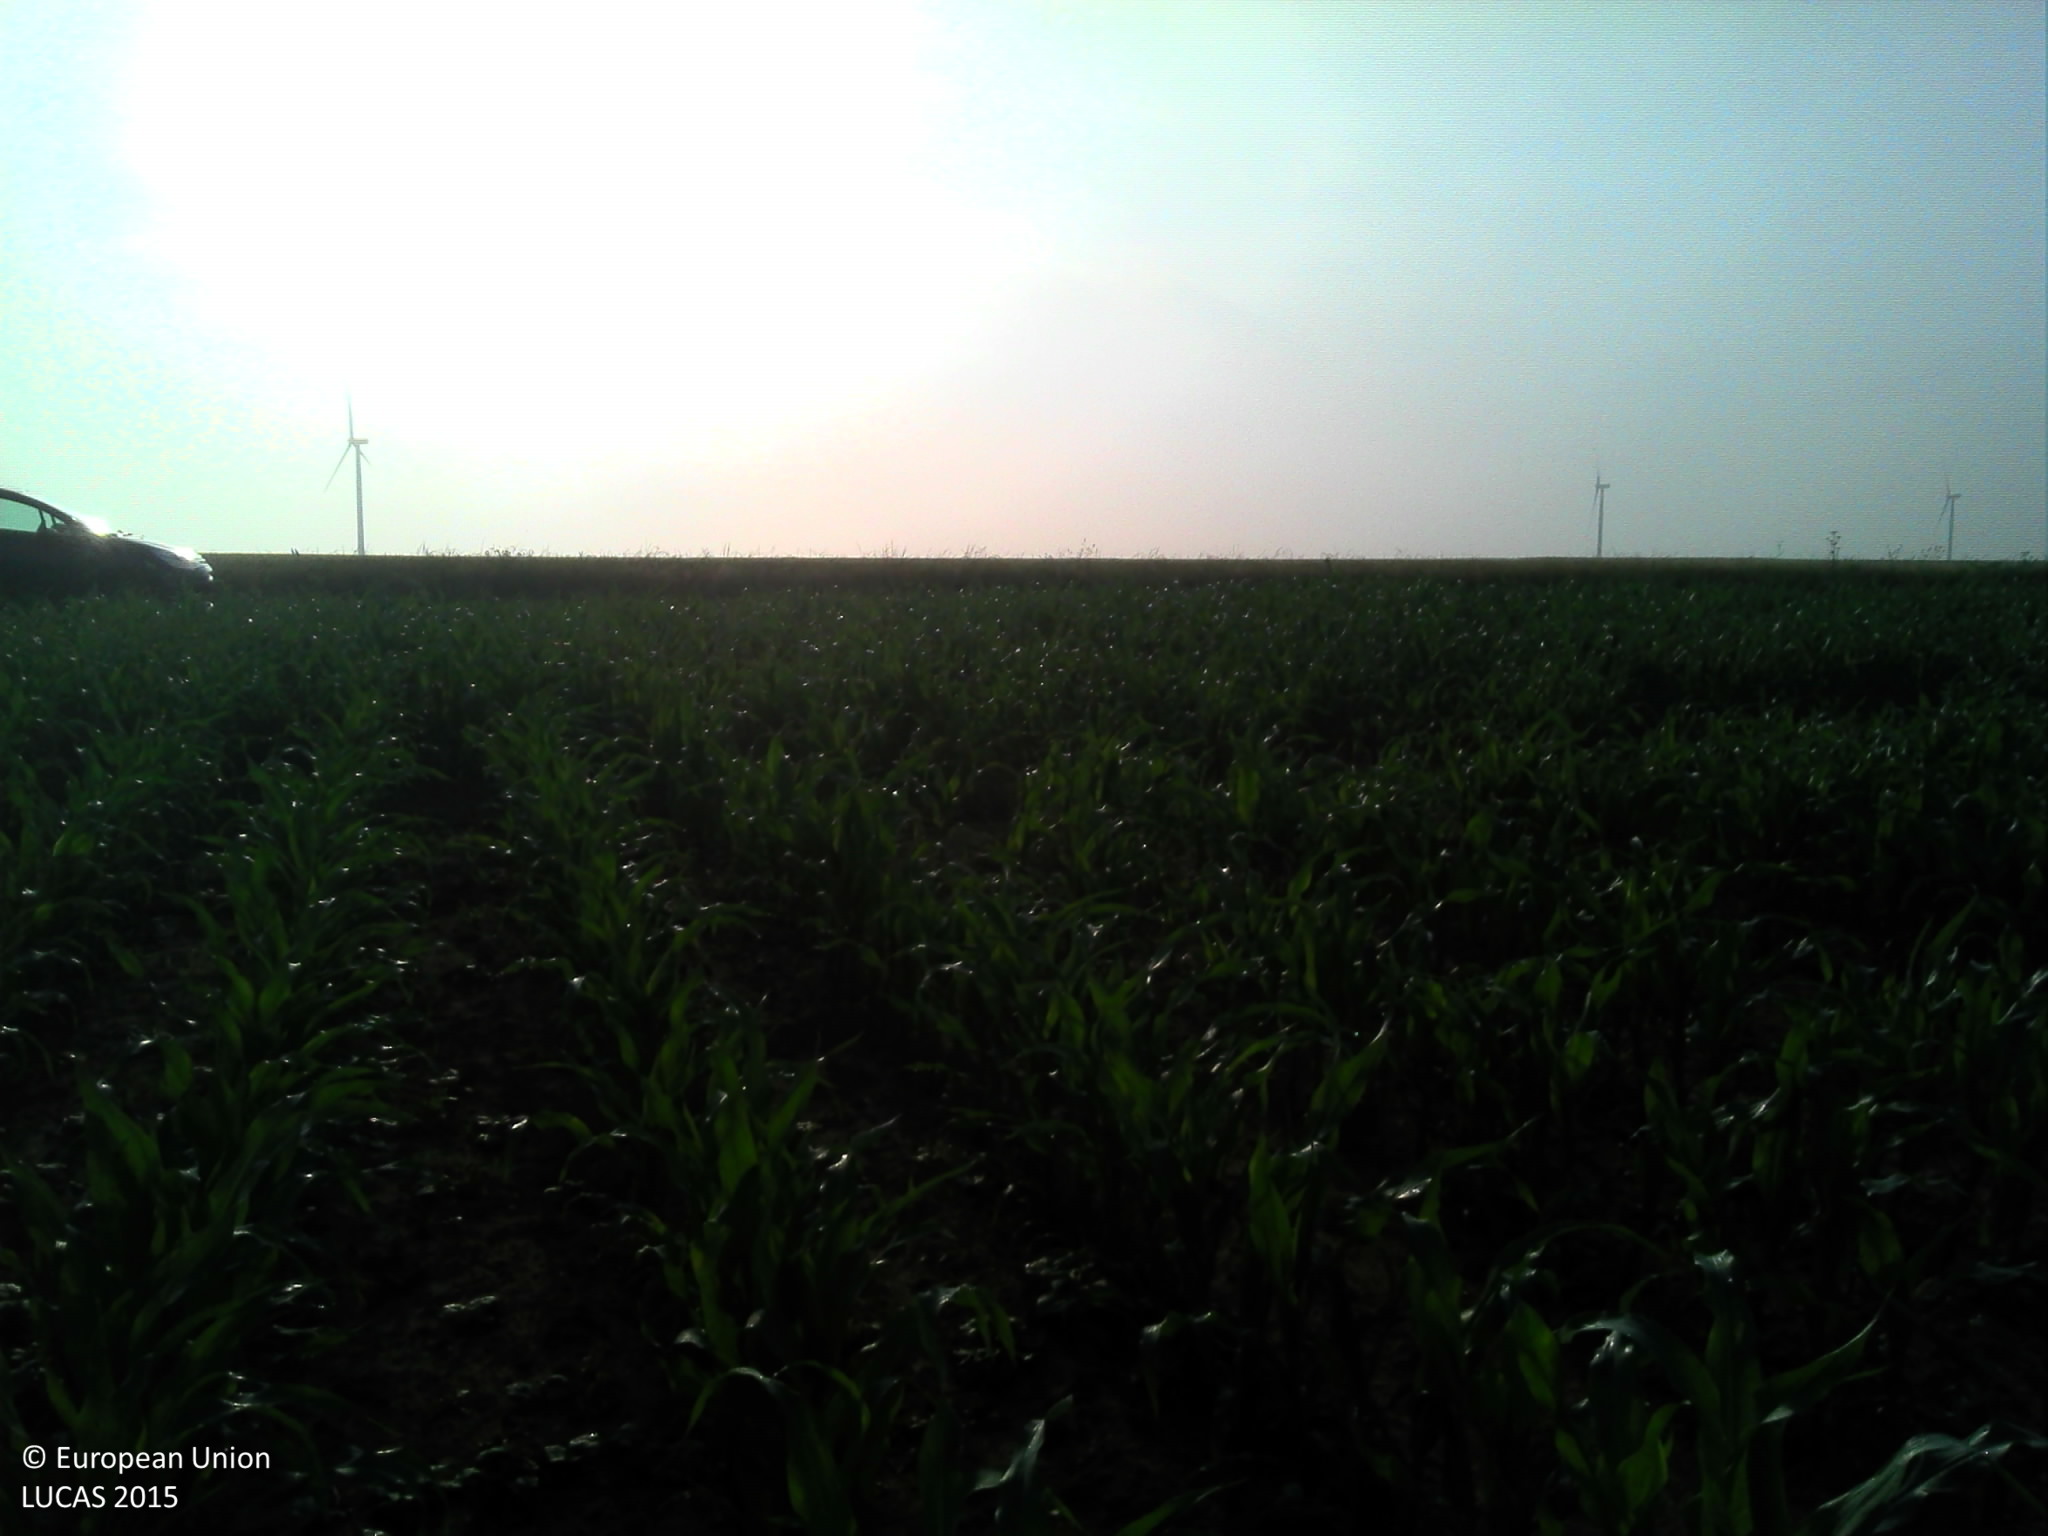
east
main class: Cropland
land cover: Maize
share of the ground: 25 - 50 %
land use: Agriculture (excluding fallow land and kitchen gardens)
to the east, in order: Maize; Grass margins; Paved roads, cycling and walking lanes; Grass margins; Common wheat
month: July
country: FR
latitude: 49.7426
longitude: 2.5640
